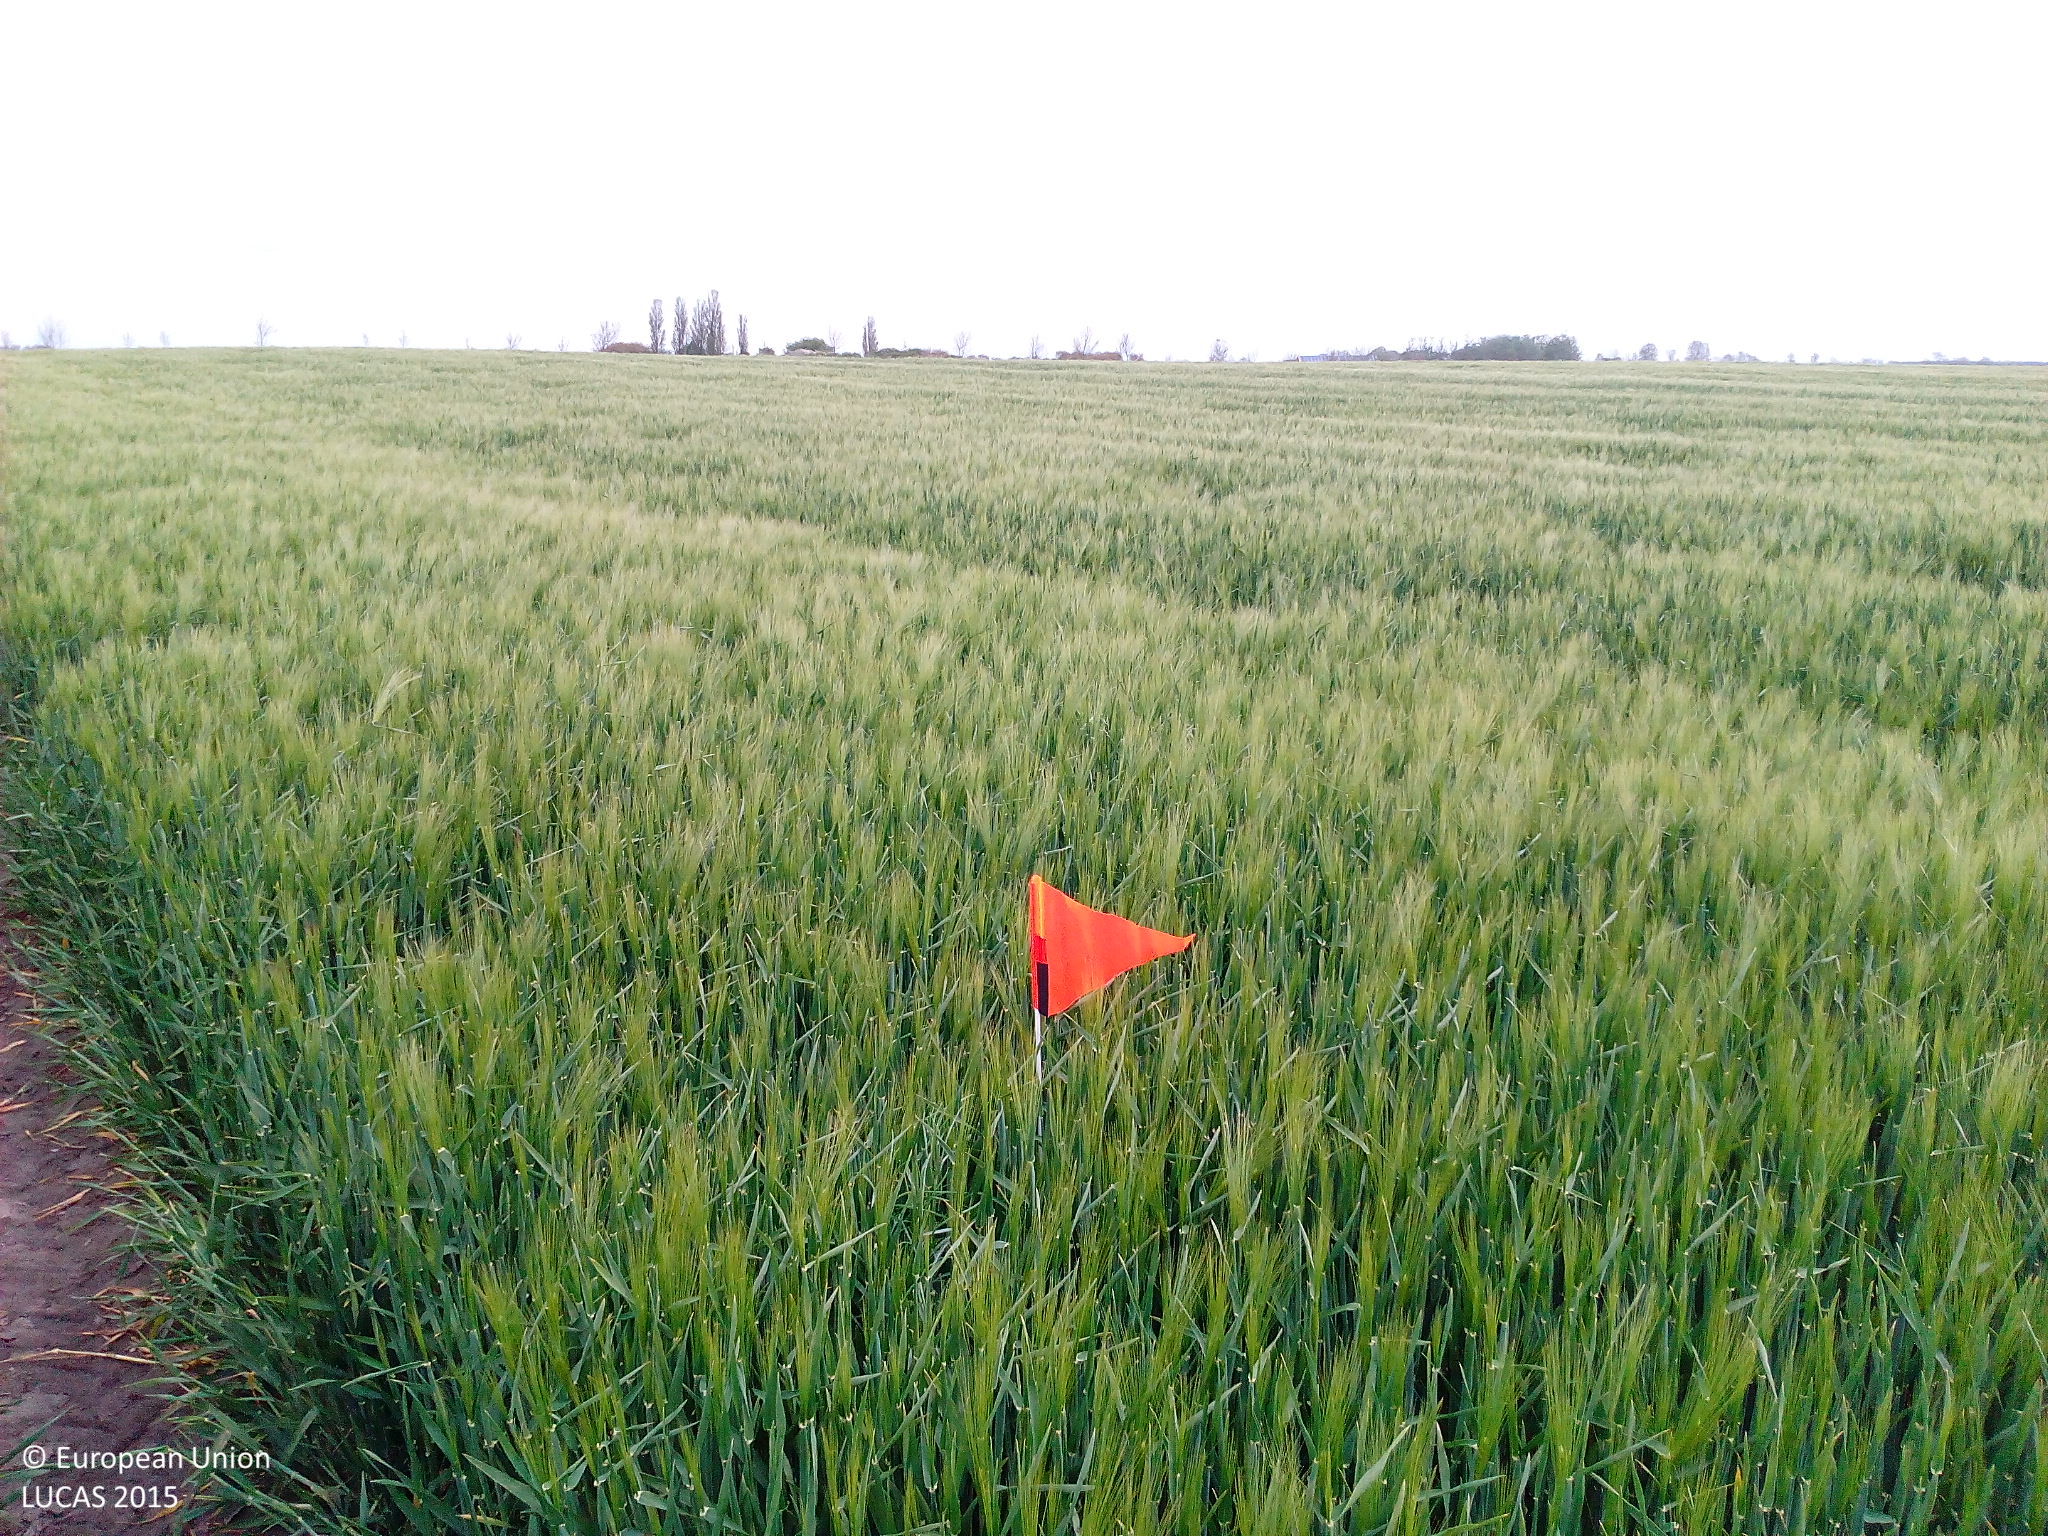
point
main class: Cropland
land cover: Barley
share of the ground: > 75 %
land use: Agriculture (excluding fallow land and kitchen gardens)
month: May
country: DE
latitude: 54.6155
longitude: 13.3283
